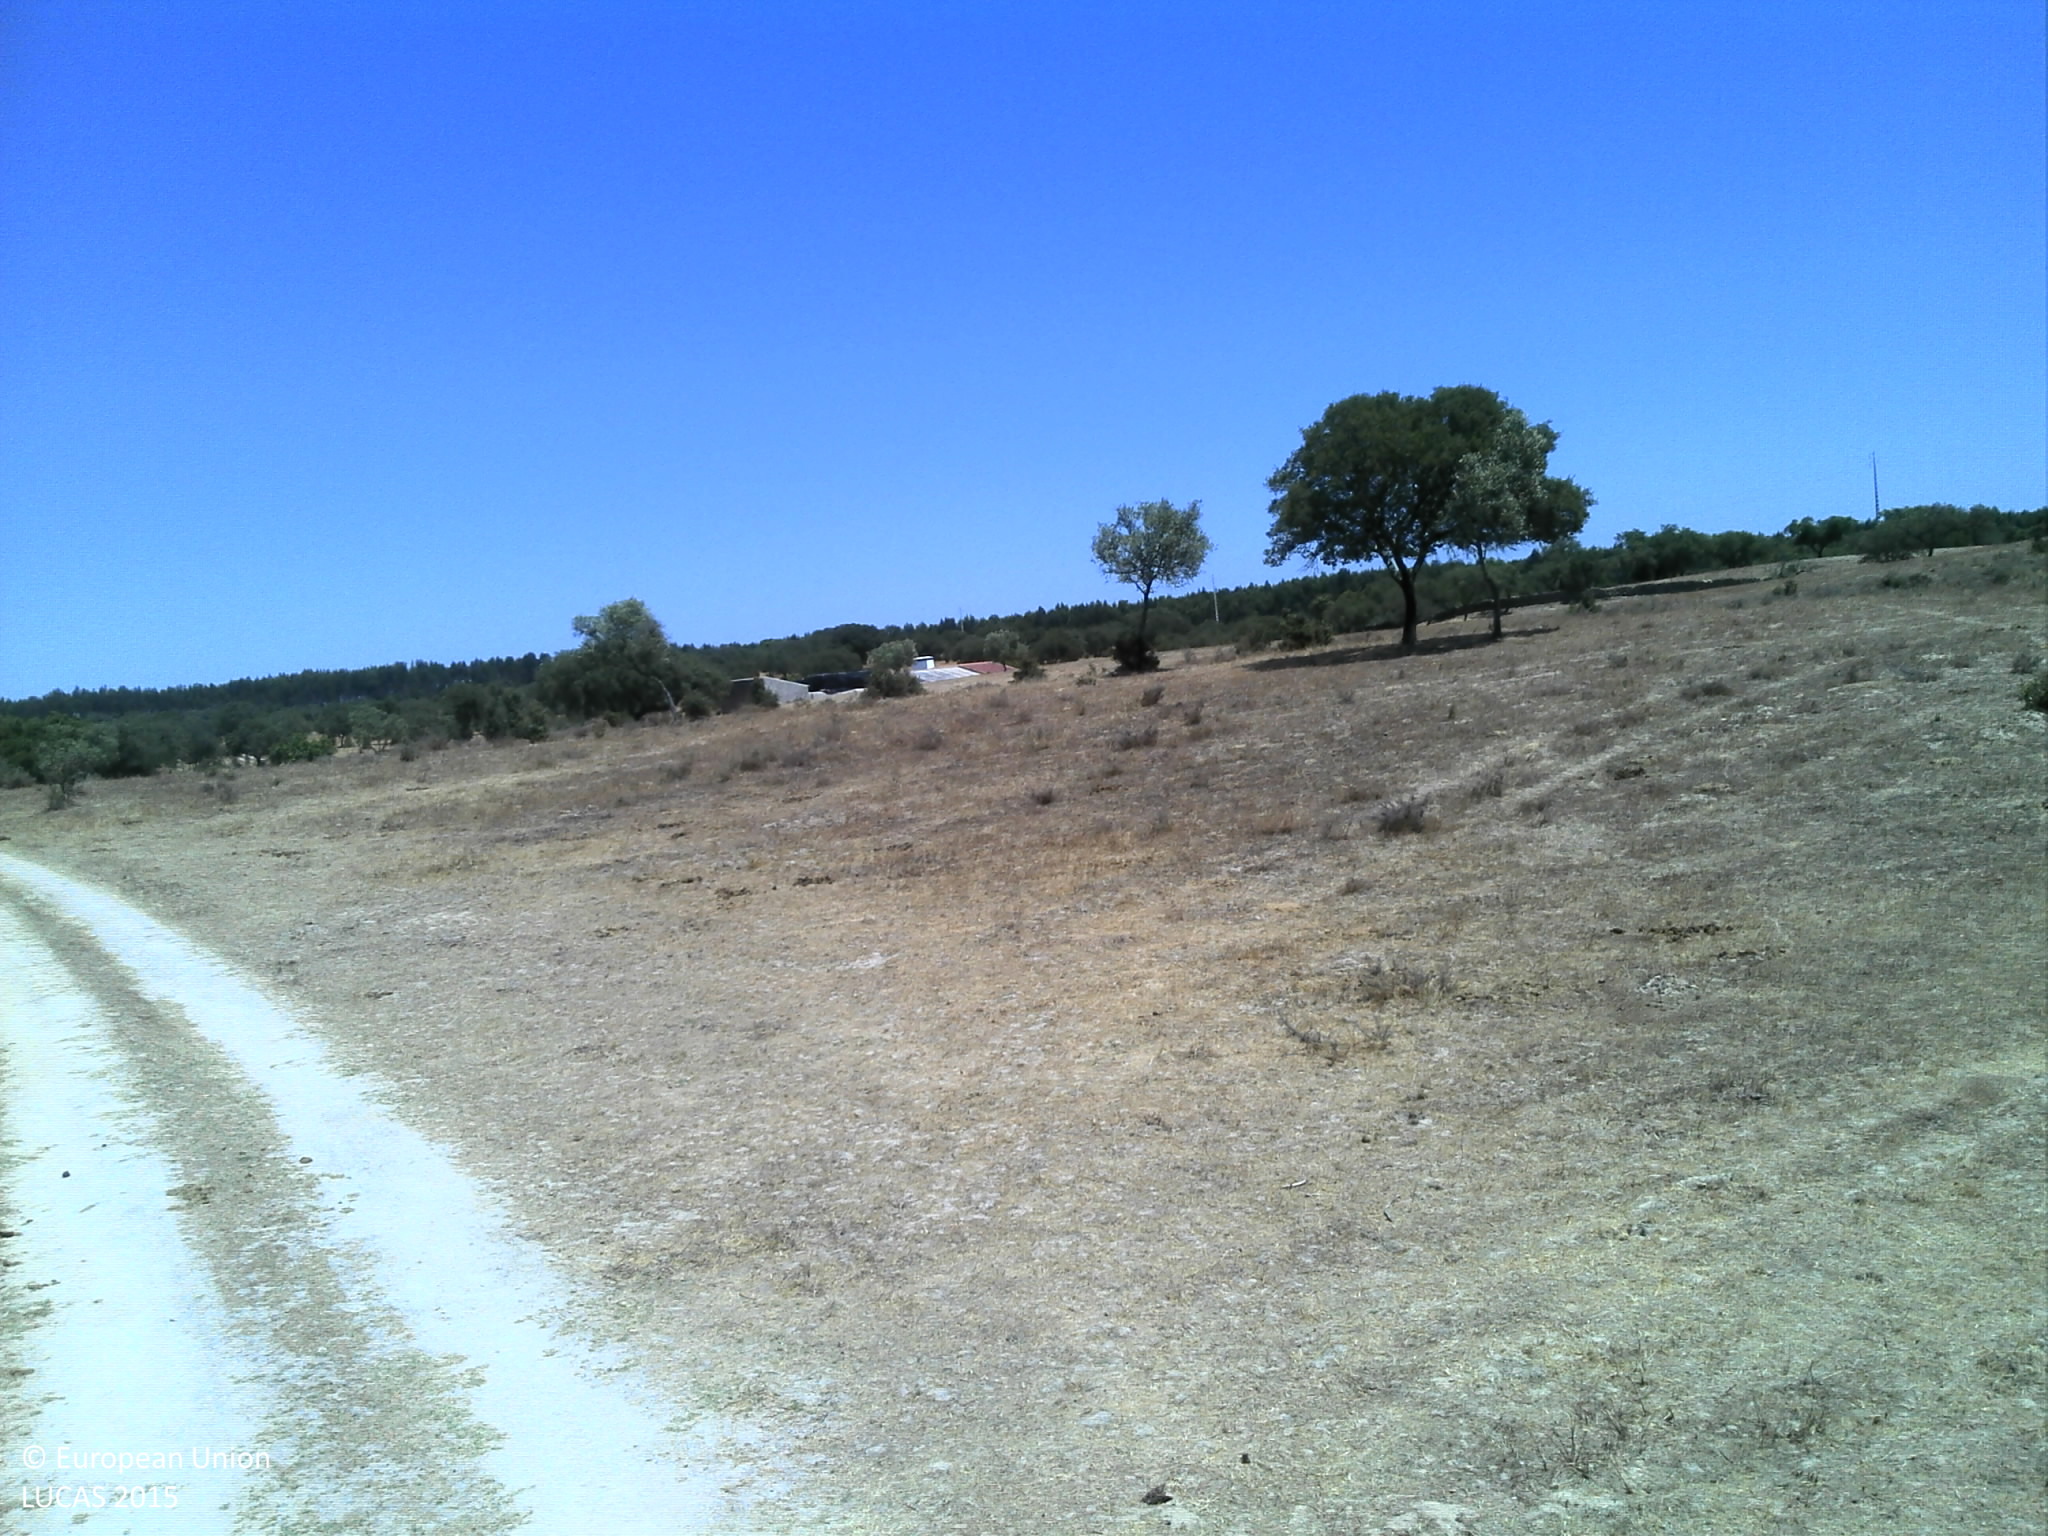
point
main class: Grassland
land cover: Grassland with sparse tree/shrub cover
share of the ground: 10 - 25 %
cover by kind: unconsolidated bare surface 80 %, herbaceous plants 15 %, broadleaved forest trees 5 %
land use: Agriculture (excluding fallow land and kitchen gardens)
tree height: > 5 m
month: July
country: PT
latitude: 39.3241
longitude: -7.7153
